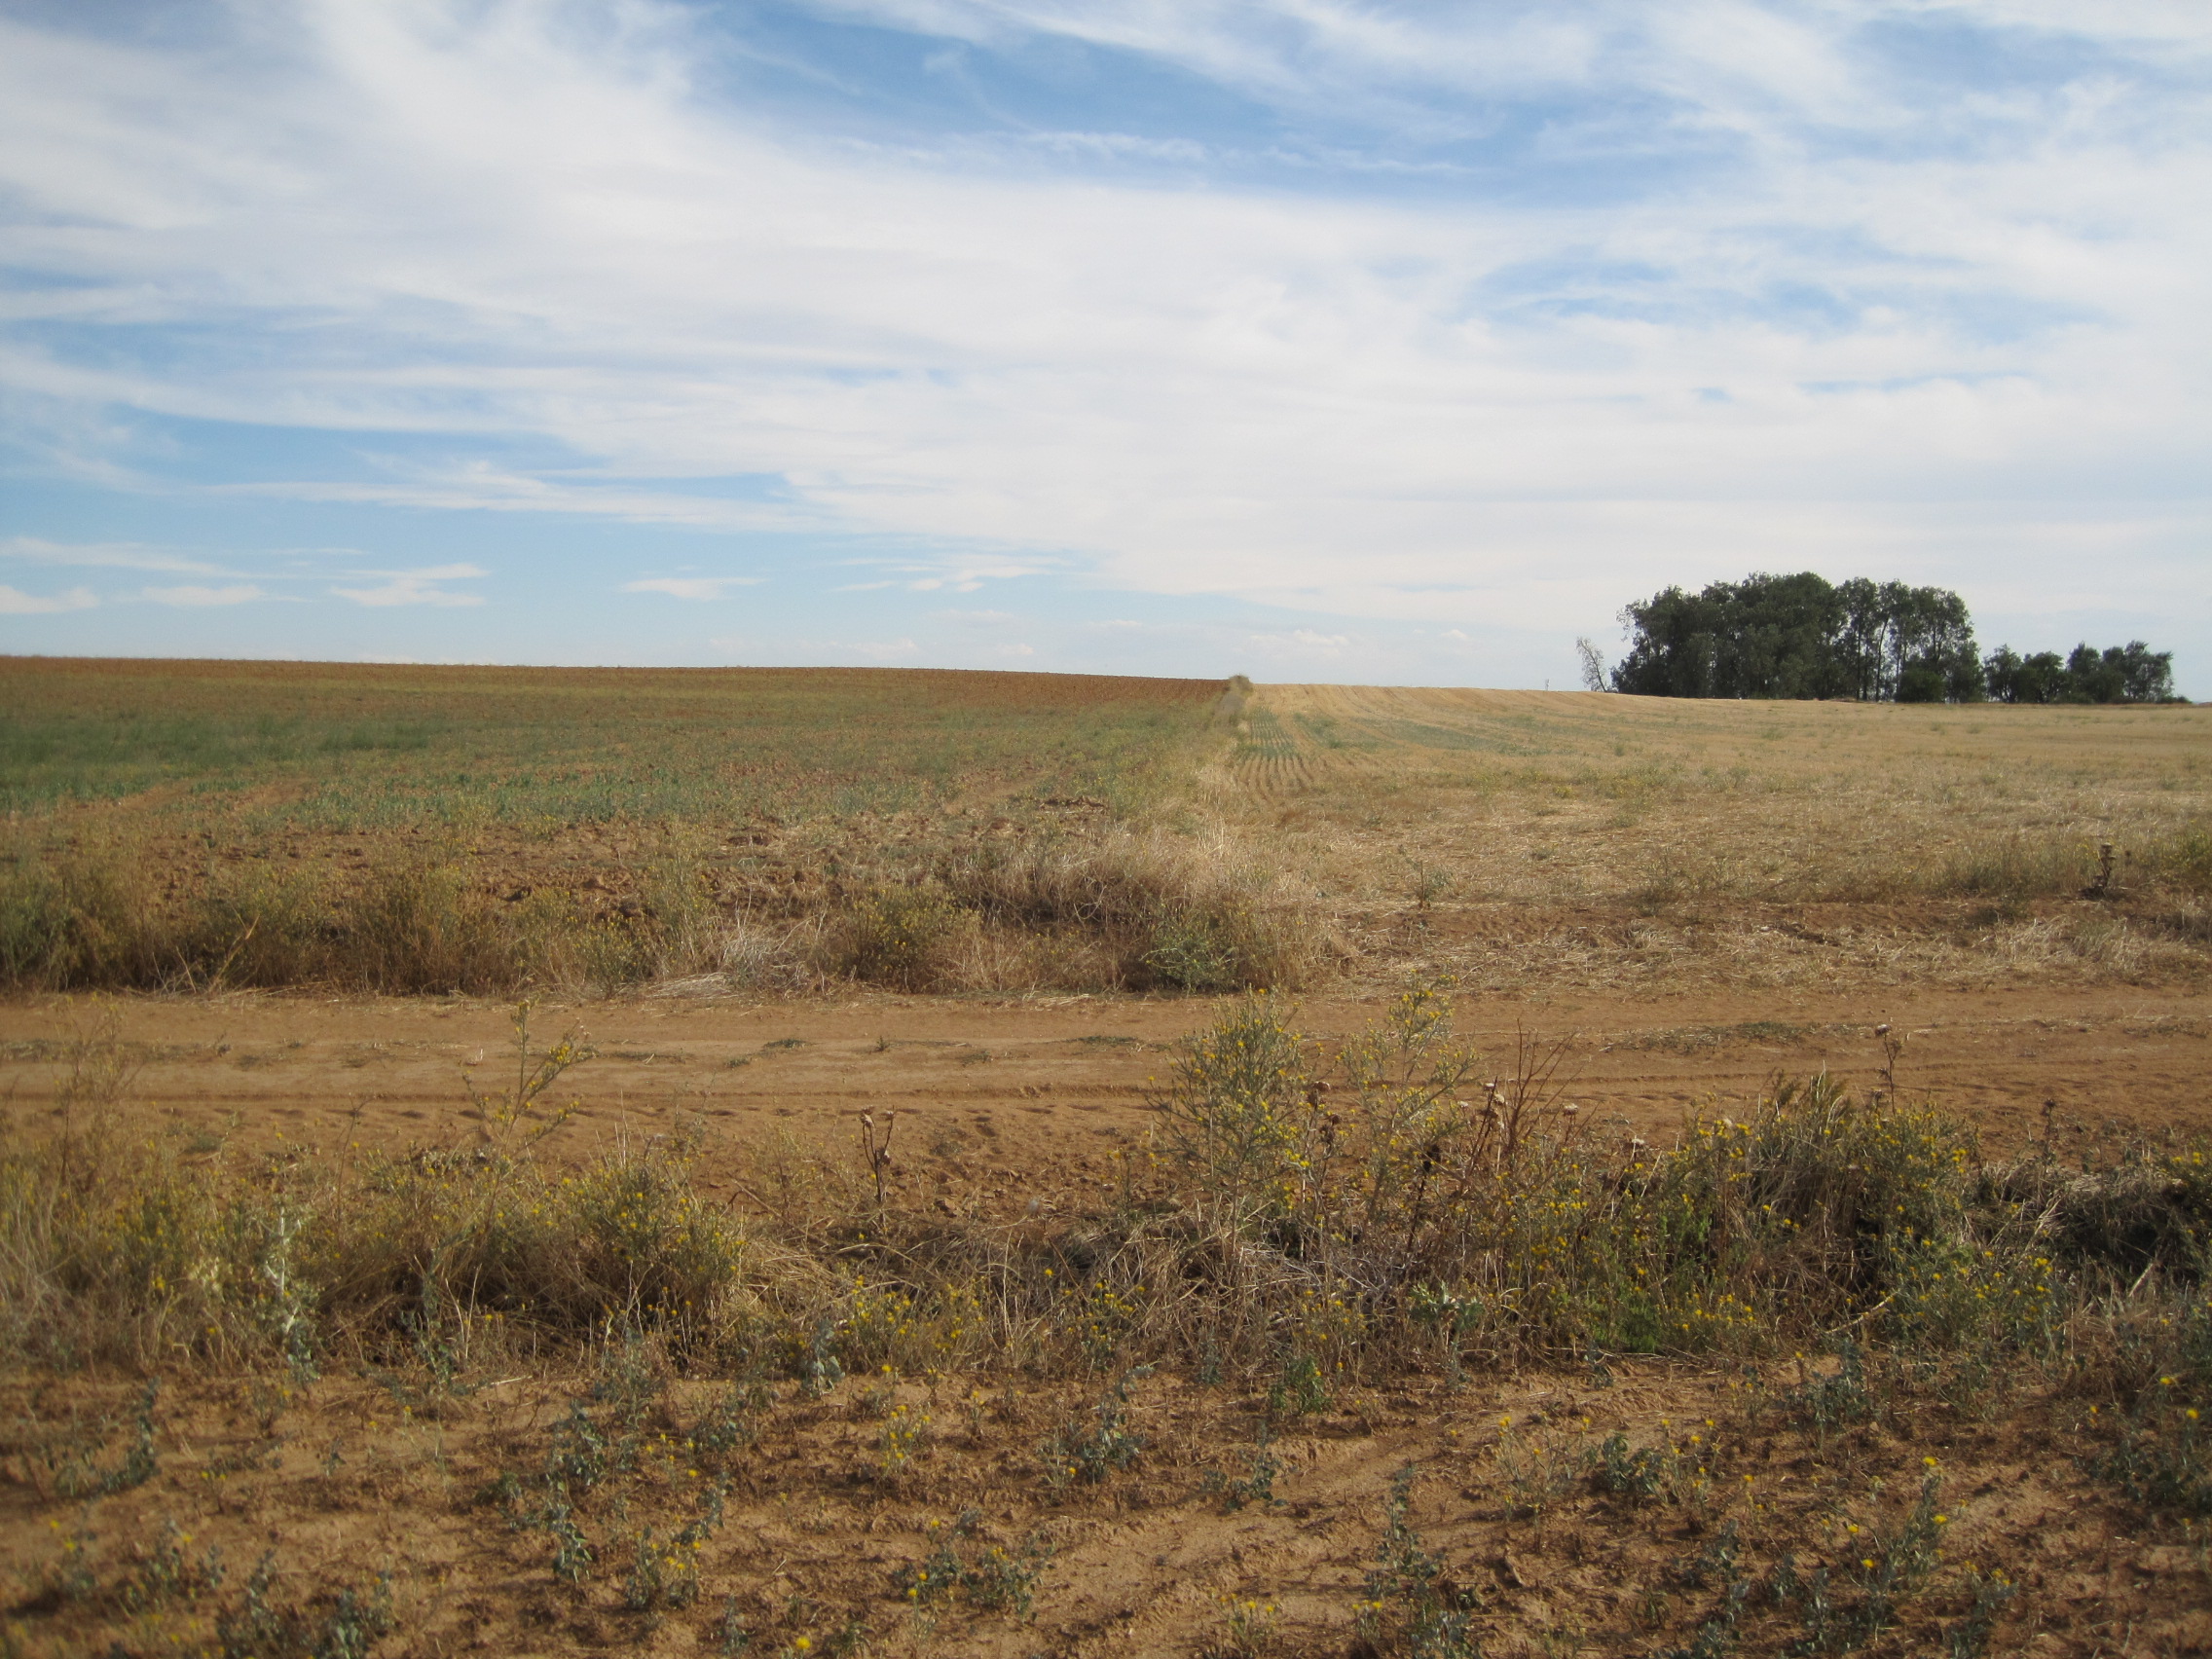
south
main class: Cropland
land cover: Dry pulses
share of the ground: < 10 %
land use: Agriculture (excluding fallow land and kitchen gardens)
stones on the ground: < 10 %
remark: Harvested field
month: July
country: ES
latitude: 41.9647
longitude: -5.2745
